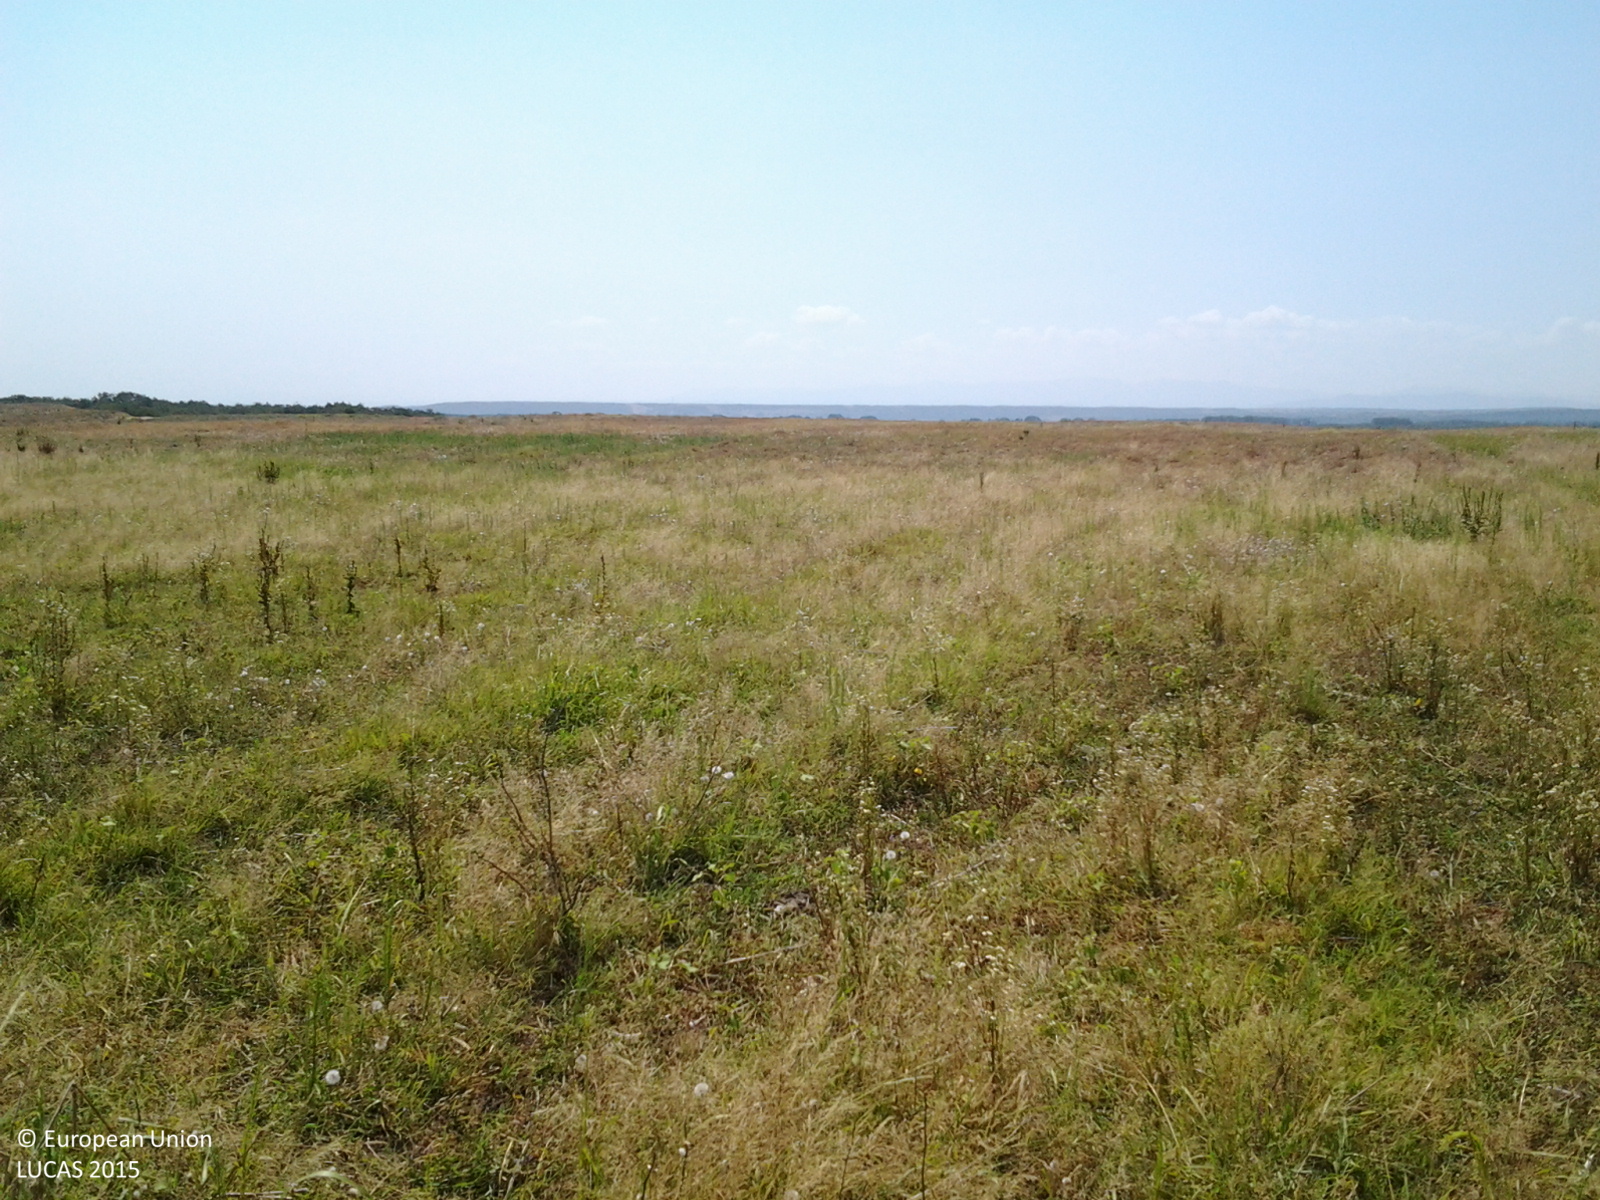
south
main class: Grassland
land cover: Grassland without tree/shrub cover
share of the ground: > 75 %
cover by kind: herbaceous plants 100 %
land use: Agriculture (excluding fallow land and kitchen gardens)
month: August
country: RO
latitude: 43.8824
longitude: 22.9465
